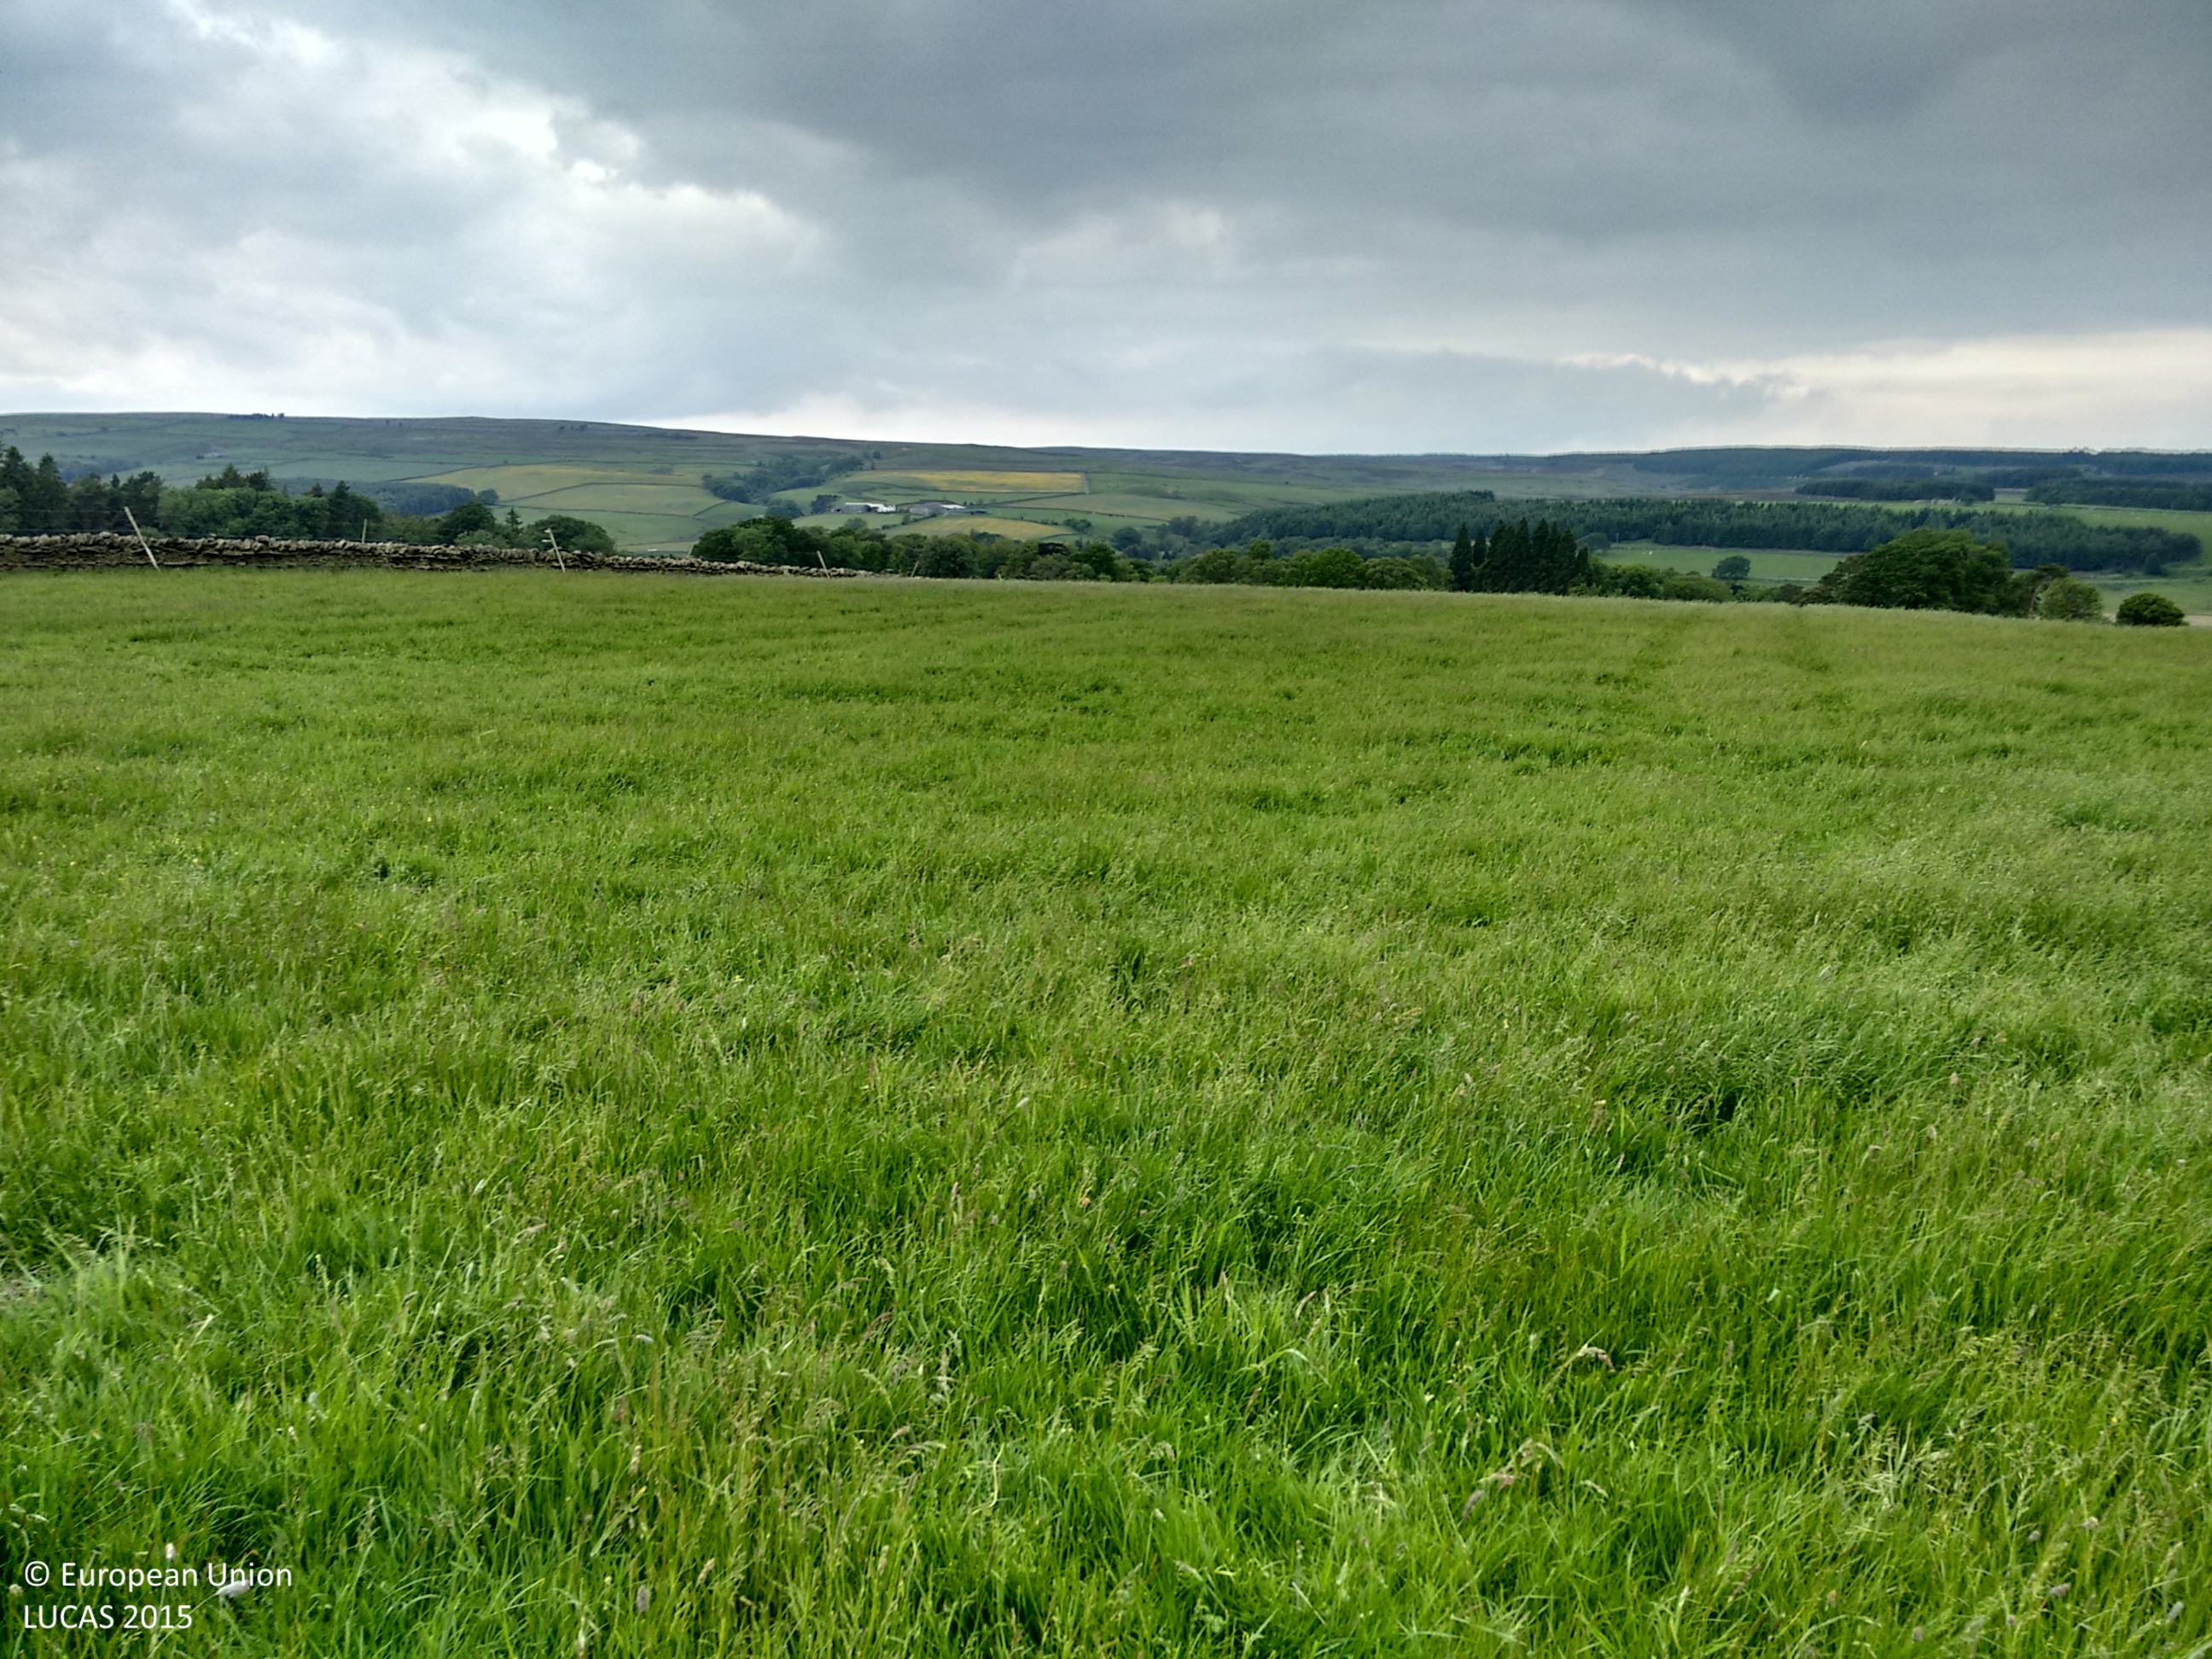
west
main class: Shrubland
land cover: Shrubland without tree cover
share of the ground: > 75 %
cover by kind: shrubs 90 %, herbaceous plants 10 %
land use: Agriculture (excluding fallow land and kitchen gardens)
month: June
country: GB
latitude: 54.8576
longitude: -2.0032
